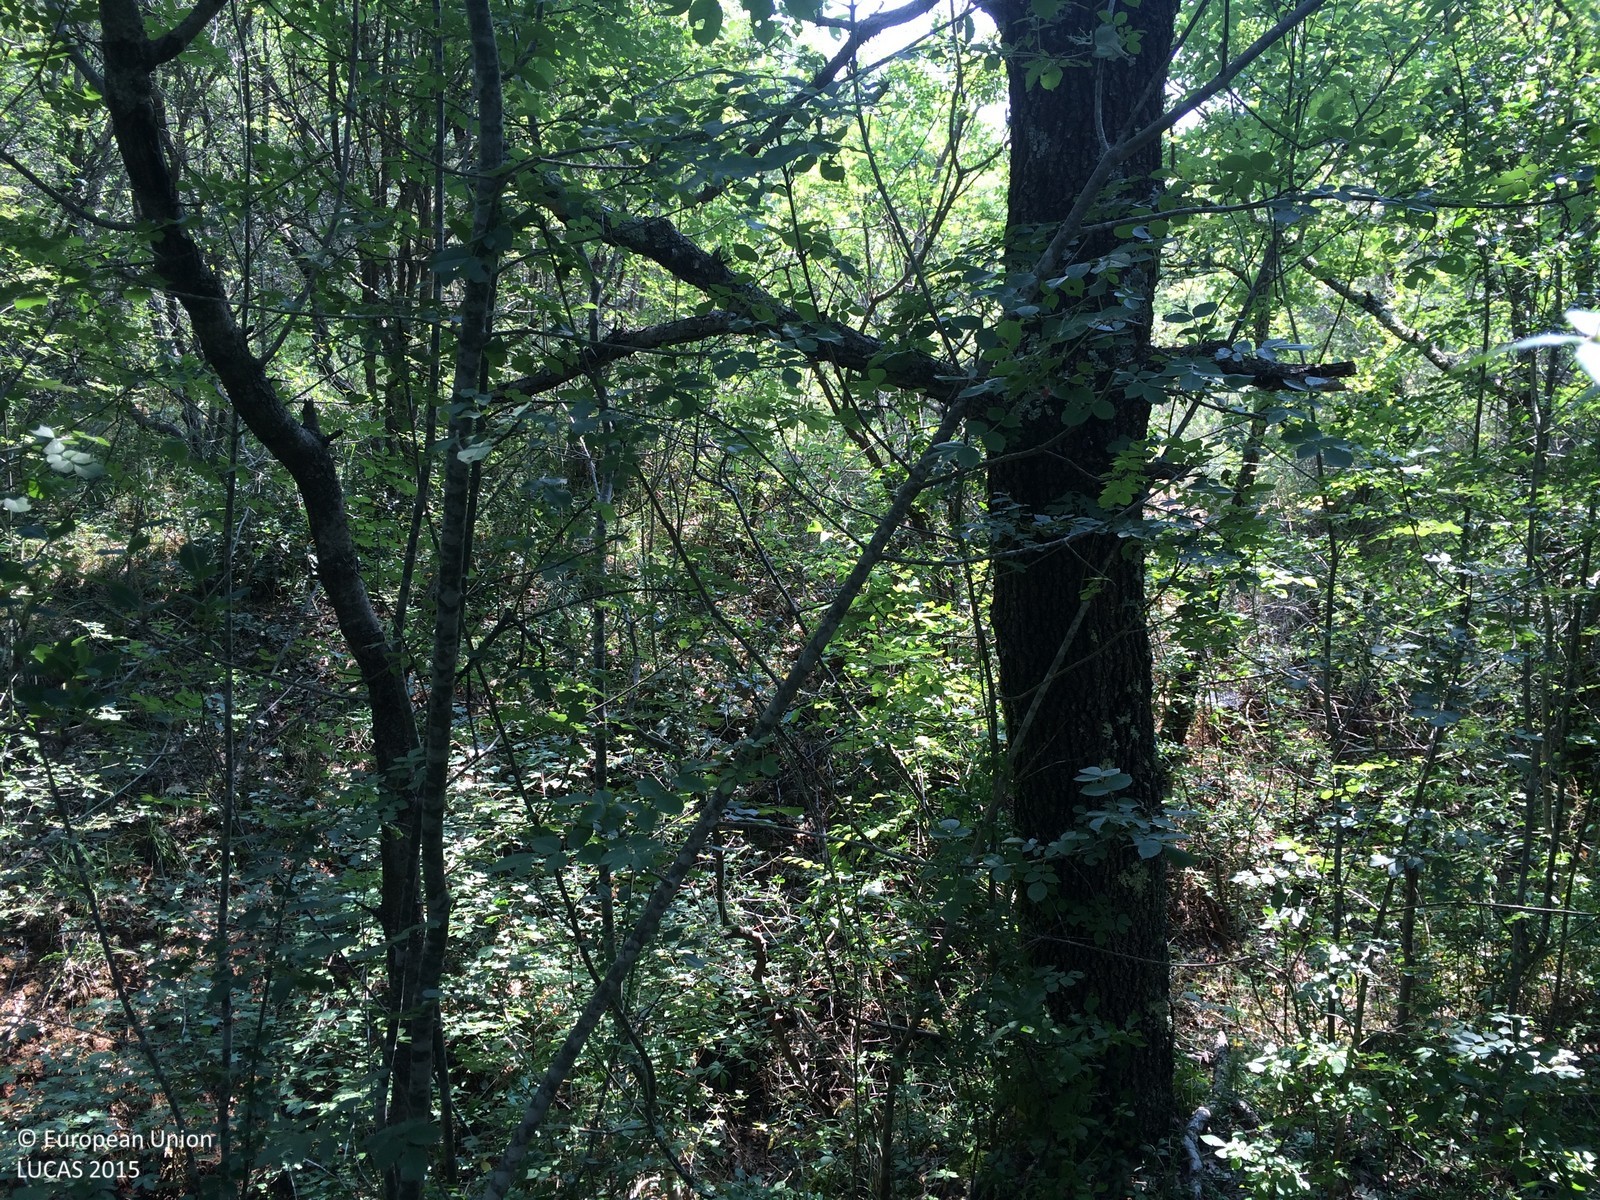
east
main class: Woodland
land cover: Broadleaved woodland
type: mesophytic deciduous forest
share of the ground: > 75 %
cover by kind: broadleaved forest trees 95 %, shrubs 5 %
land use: Semi-natural and natural areas not in use
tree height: > 5 m
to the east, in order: Broadleaved woodland; Ditches and canals; Shrubland with sparse tree cover; Dry stone walls; Shrubland with sparse tree cover; Tracks; Olive groves; Shrubland with sparse tree cover; Dry stone walls; Abandoned hedges; Olive groves; Single bushes/trees; Grassland with sparse tree/shrub cover
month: June
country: HR
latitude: 45.0971
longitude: 13.6924
